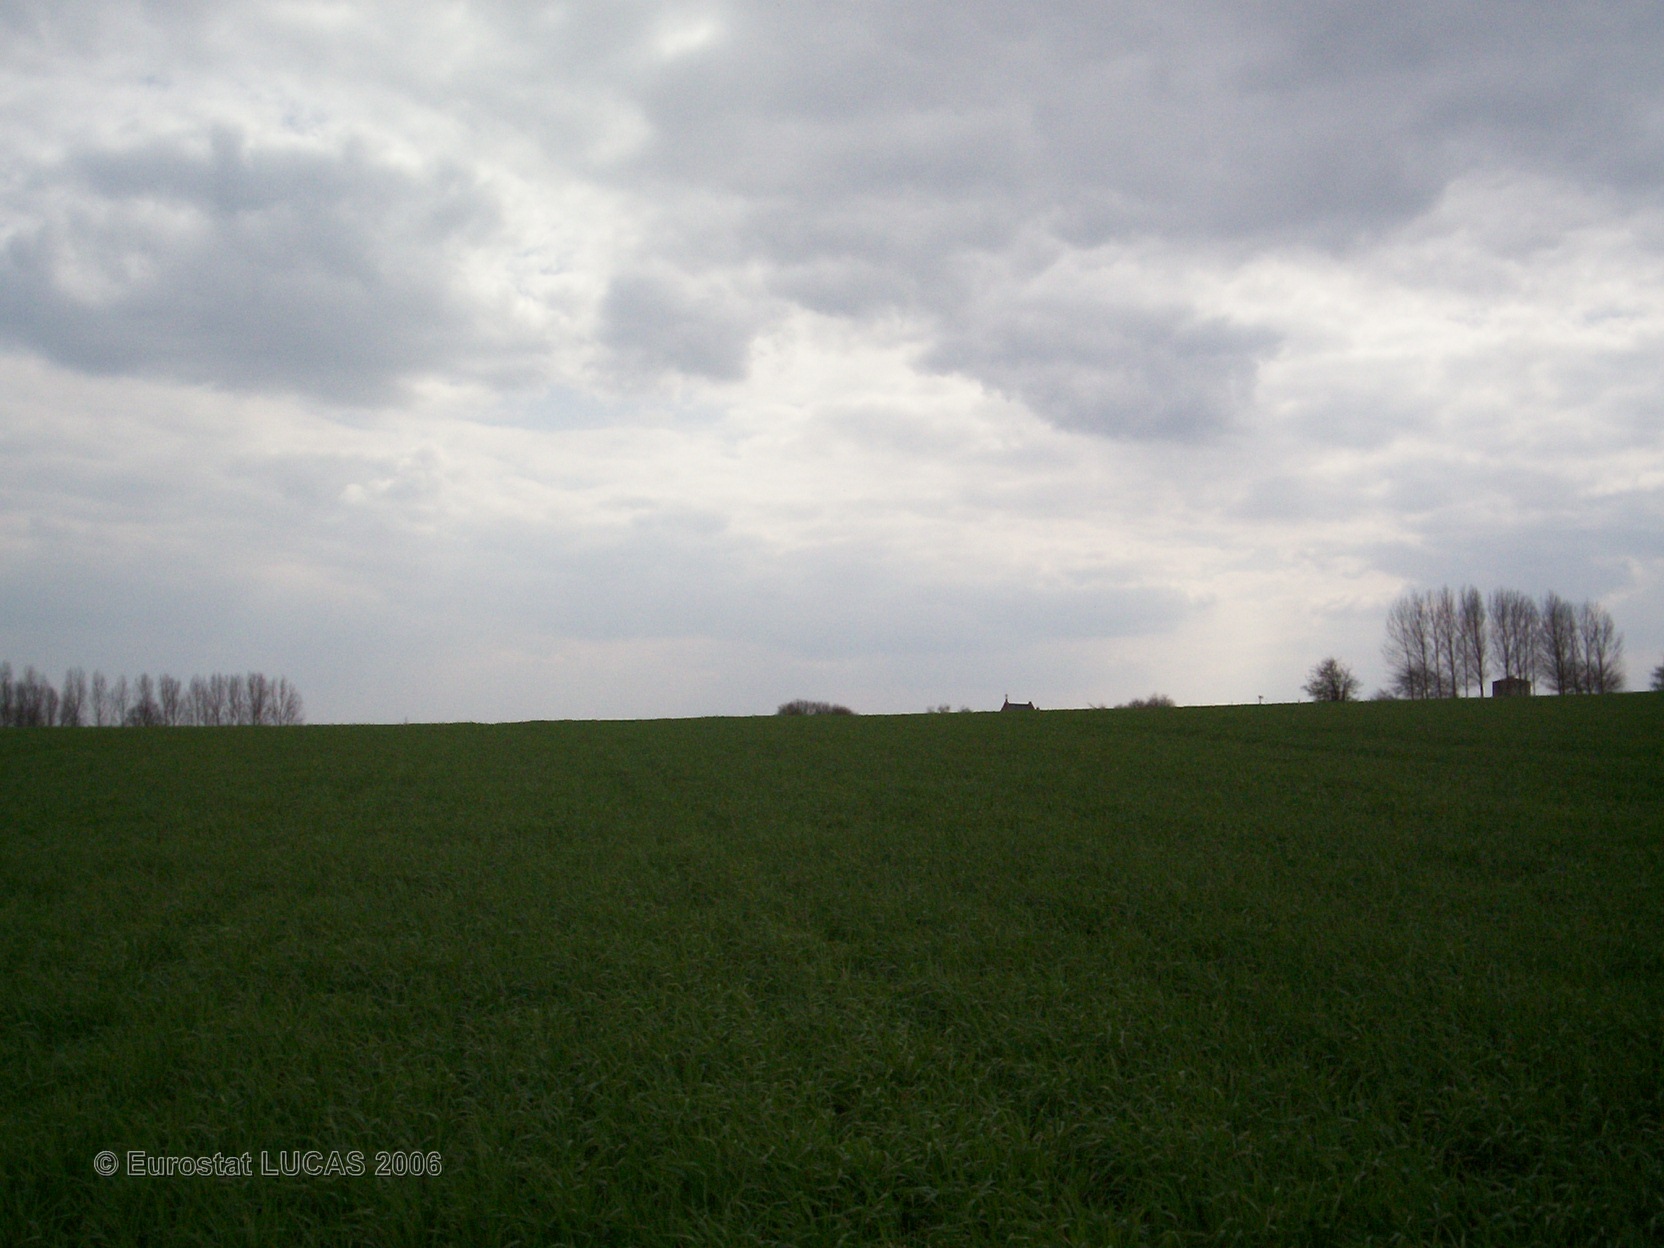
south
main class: Cropland
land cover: Common wheat
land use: Agriculture (excluding fallow land and kitchen gardens)
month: April
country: FR
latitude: 50.0323
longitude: 2.5750
